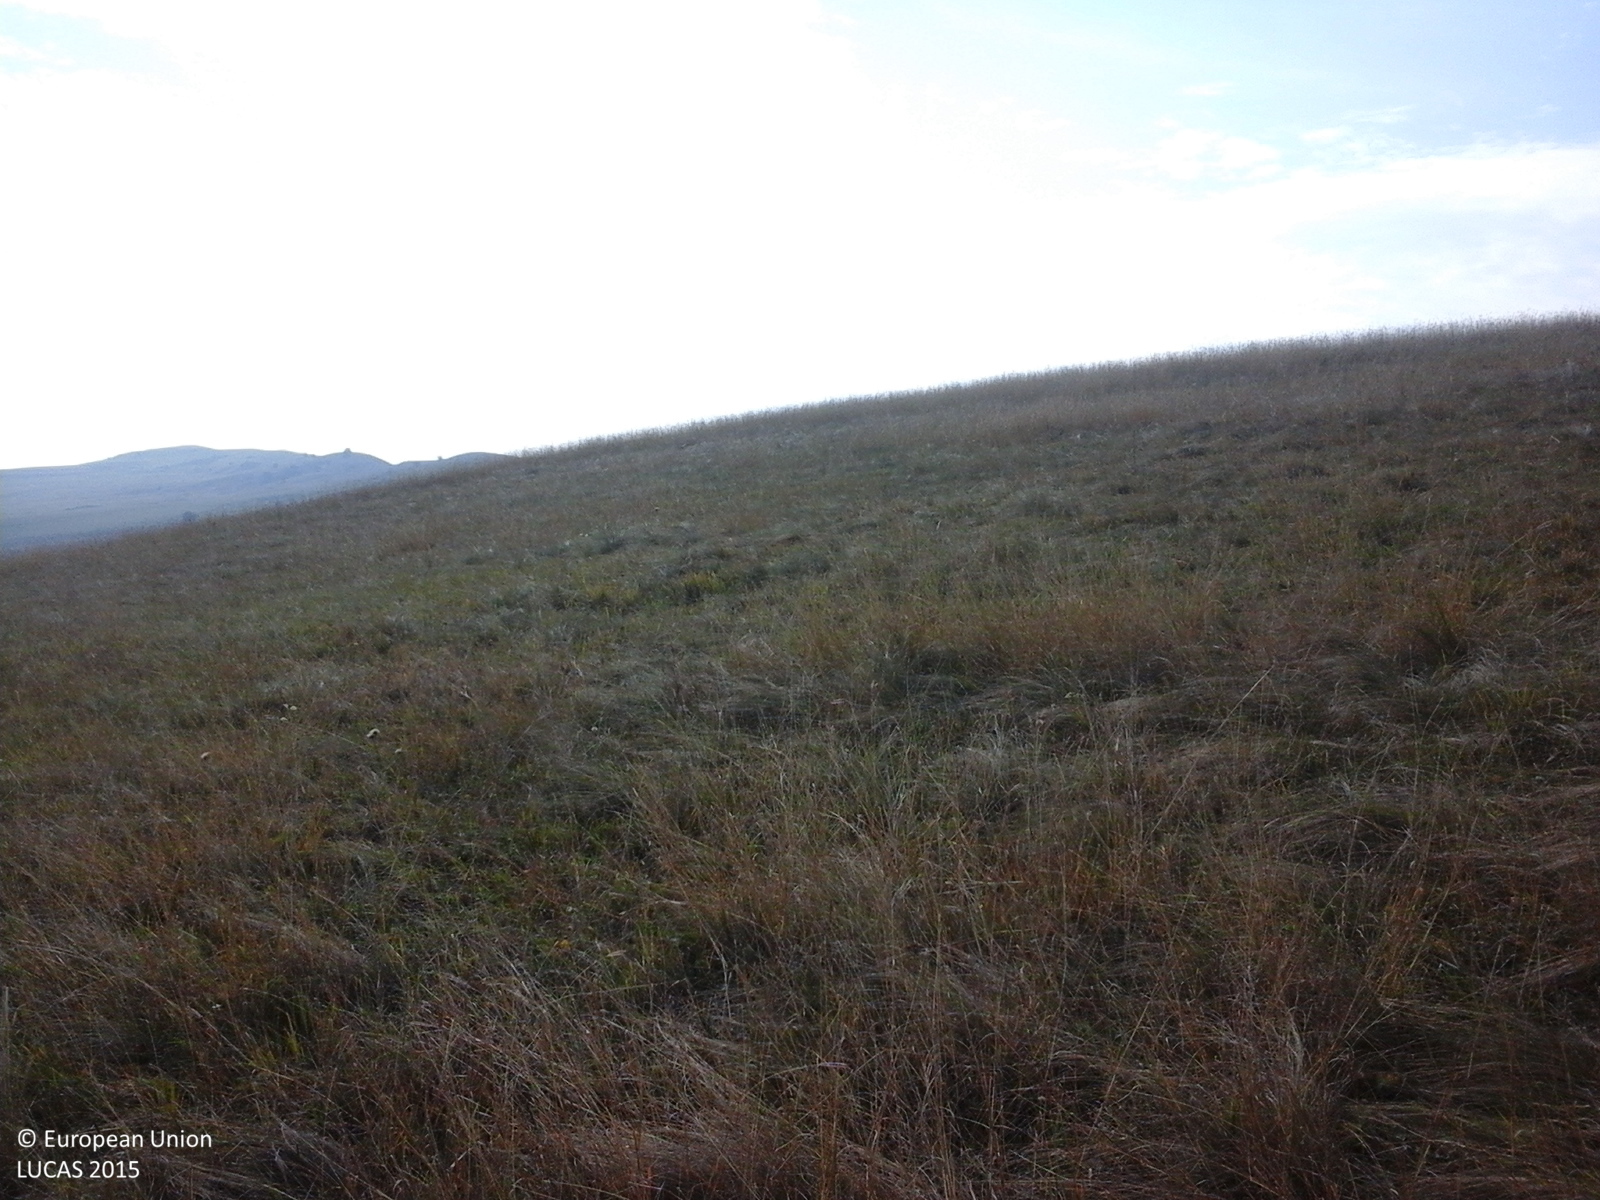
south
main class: Grassland
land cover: Grassland without tree/shrub cover
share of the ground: > 75 %
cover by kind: herbaceous plants 100 %
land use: Agriculture (excluding fallow land and kitchen gardens)
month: October
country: RO
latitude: 46.4548
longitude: 23.8085
